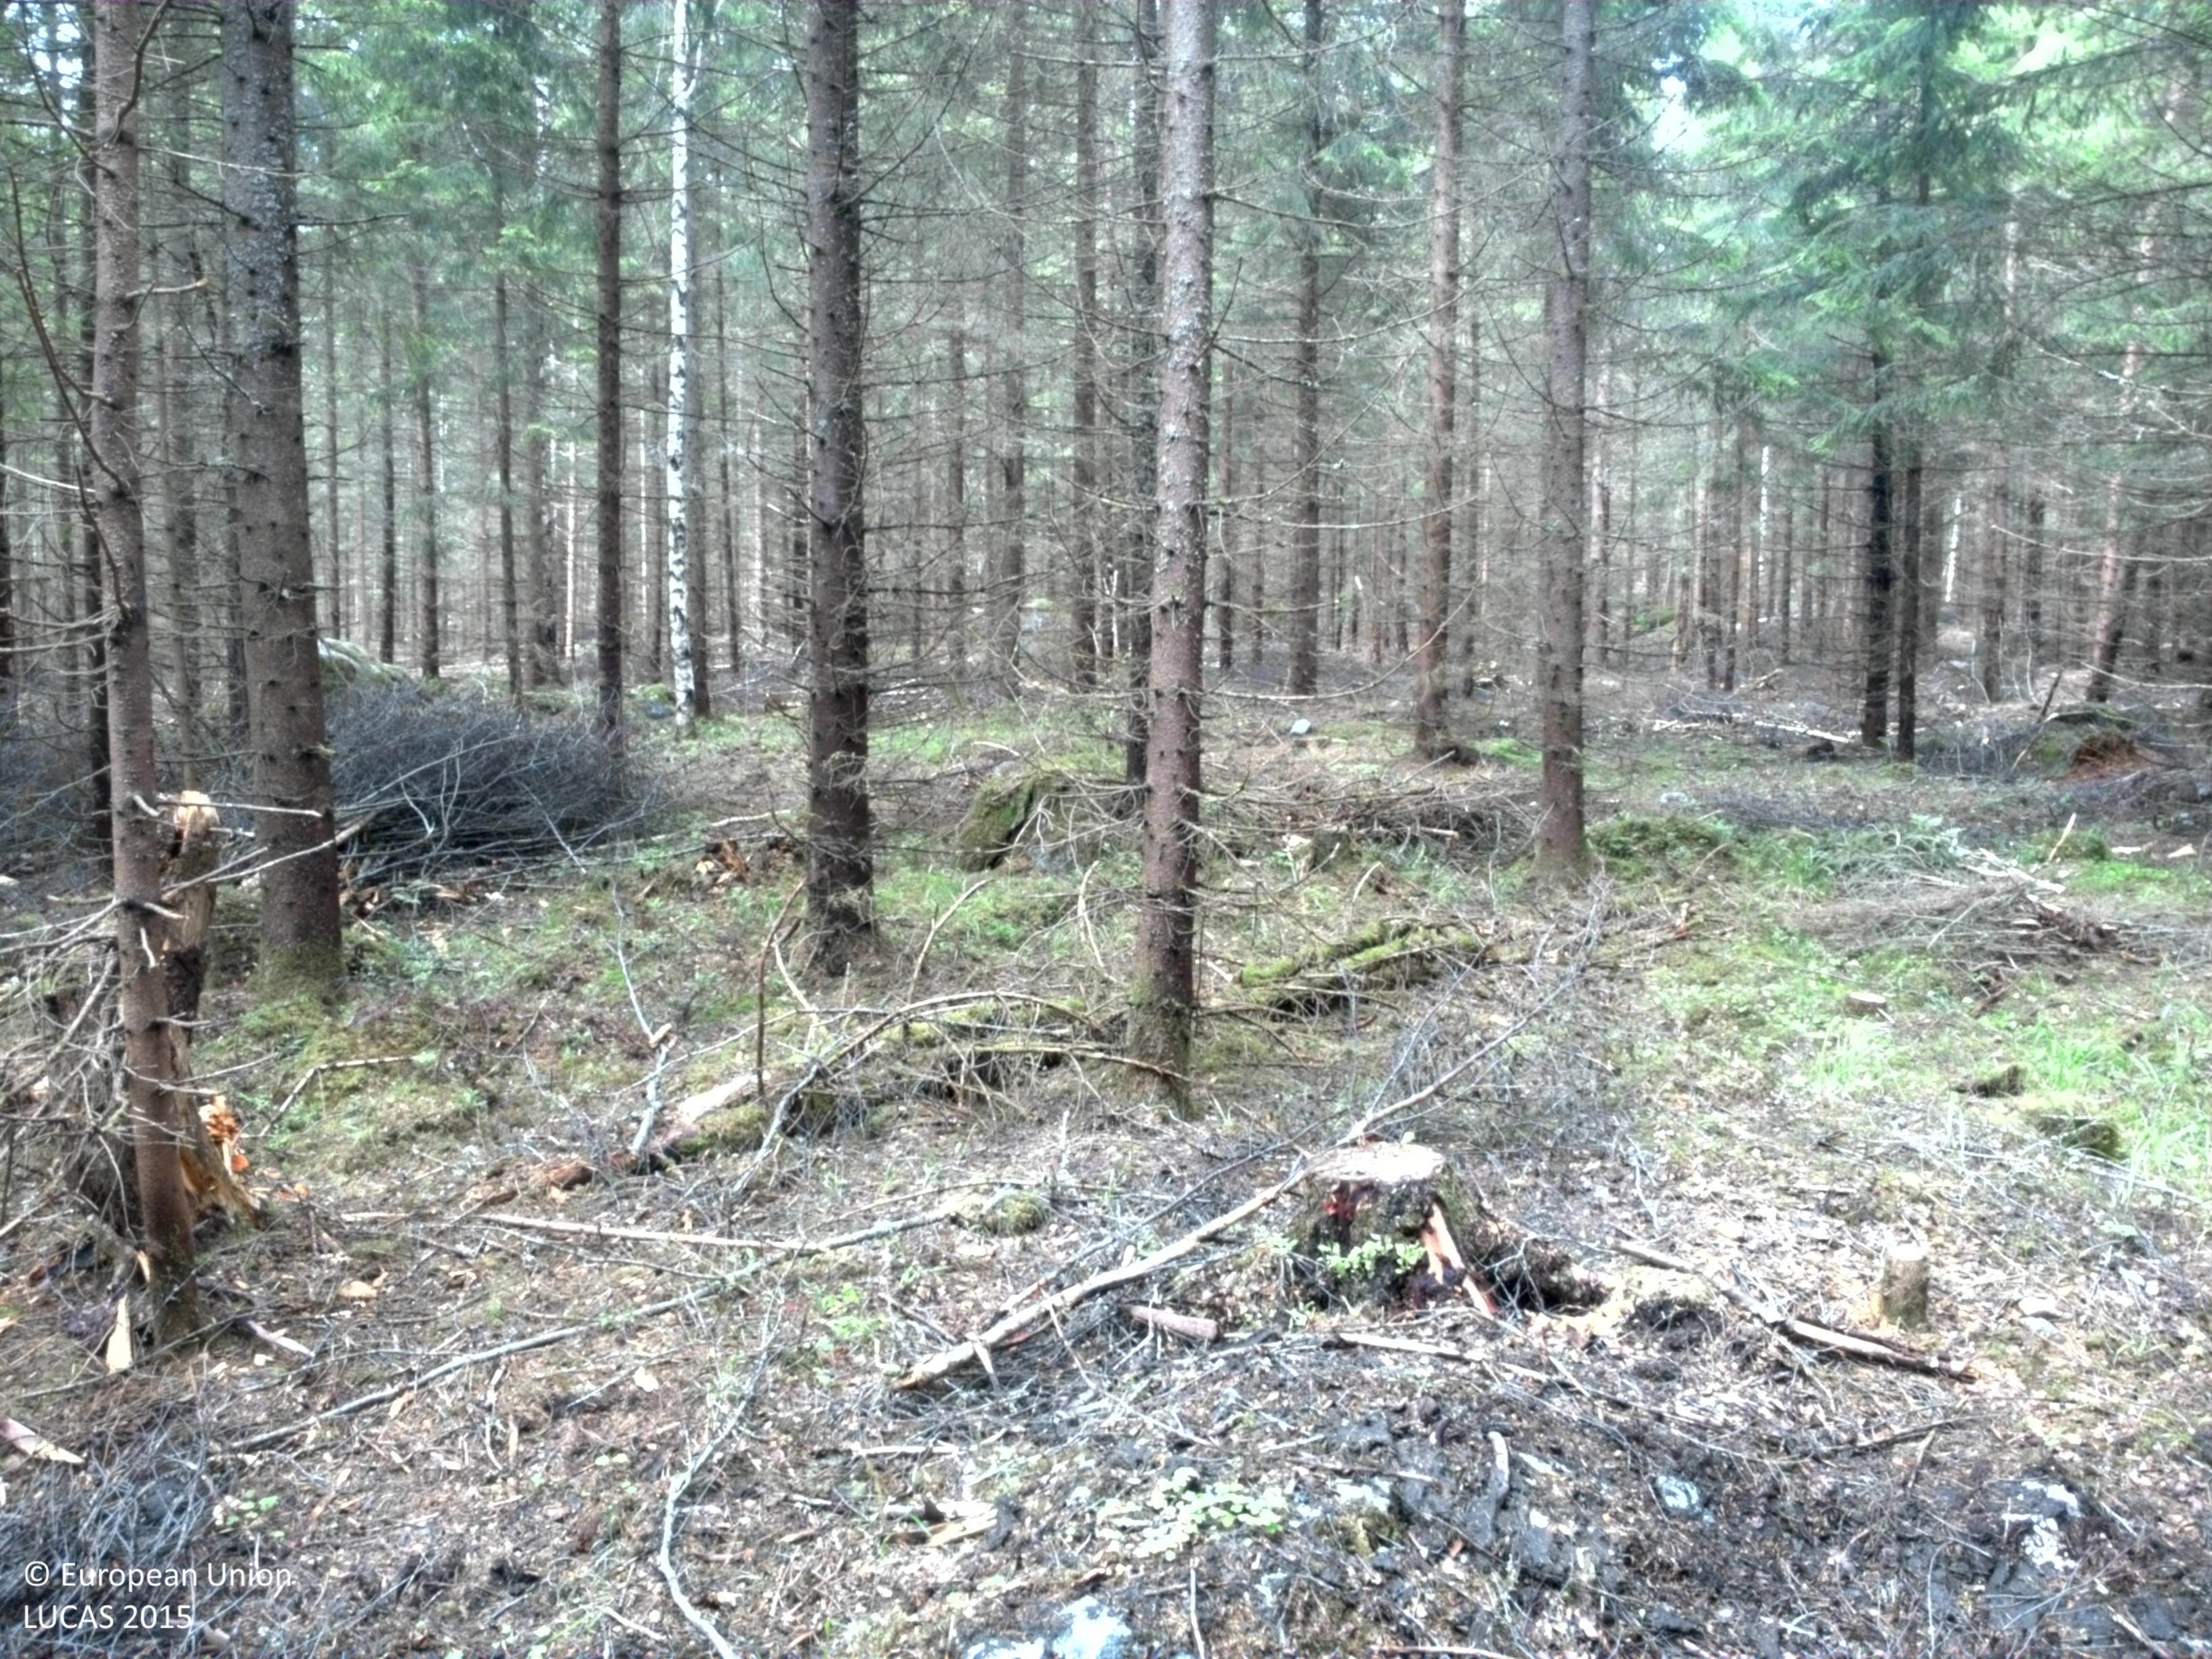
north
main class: Woodland
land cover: Spruce dominated coniferous woodland
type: boreal forest
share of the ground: > 75 %
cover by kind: coniferous forest trees 65 %, lichens and mosses 15 %, broadleaved forest trees 10 %, shrubs 5 %, consolidated bare surface 5 %
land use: Forestry
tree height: > 5 m
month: July
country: SE
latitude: 59.4040
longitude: 14.5533
